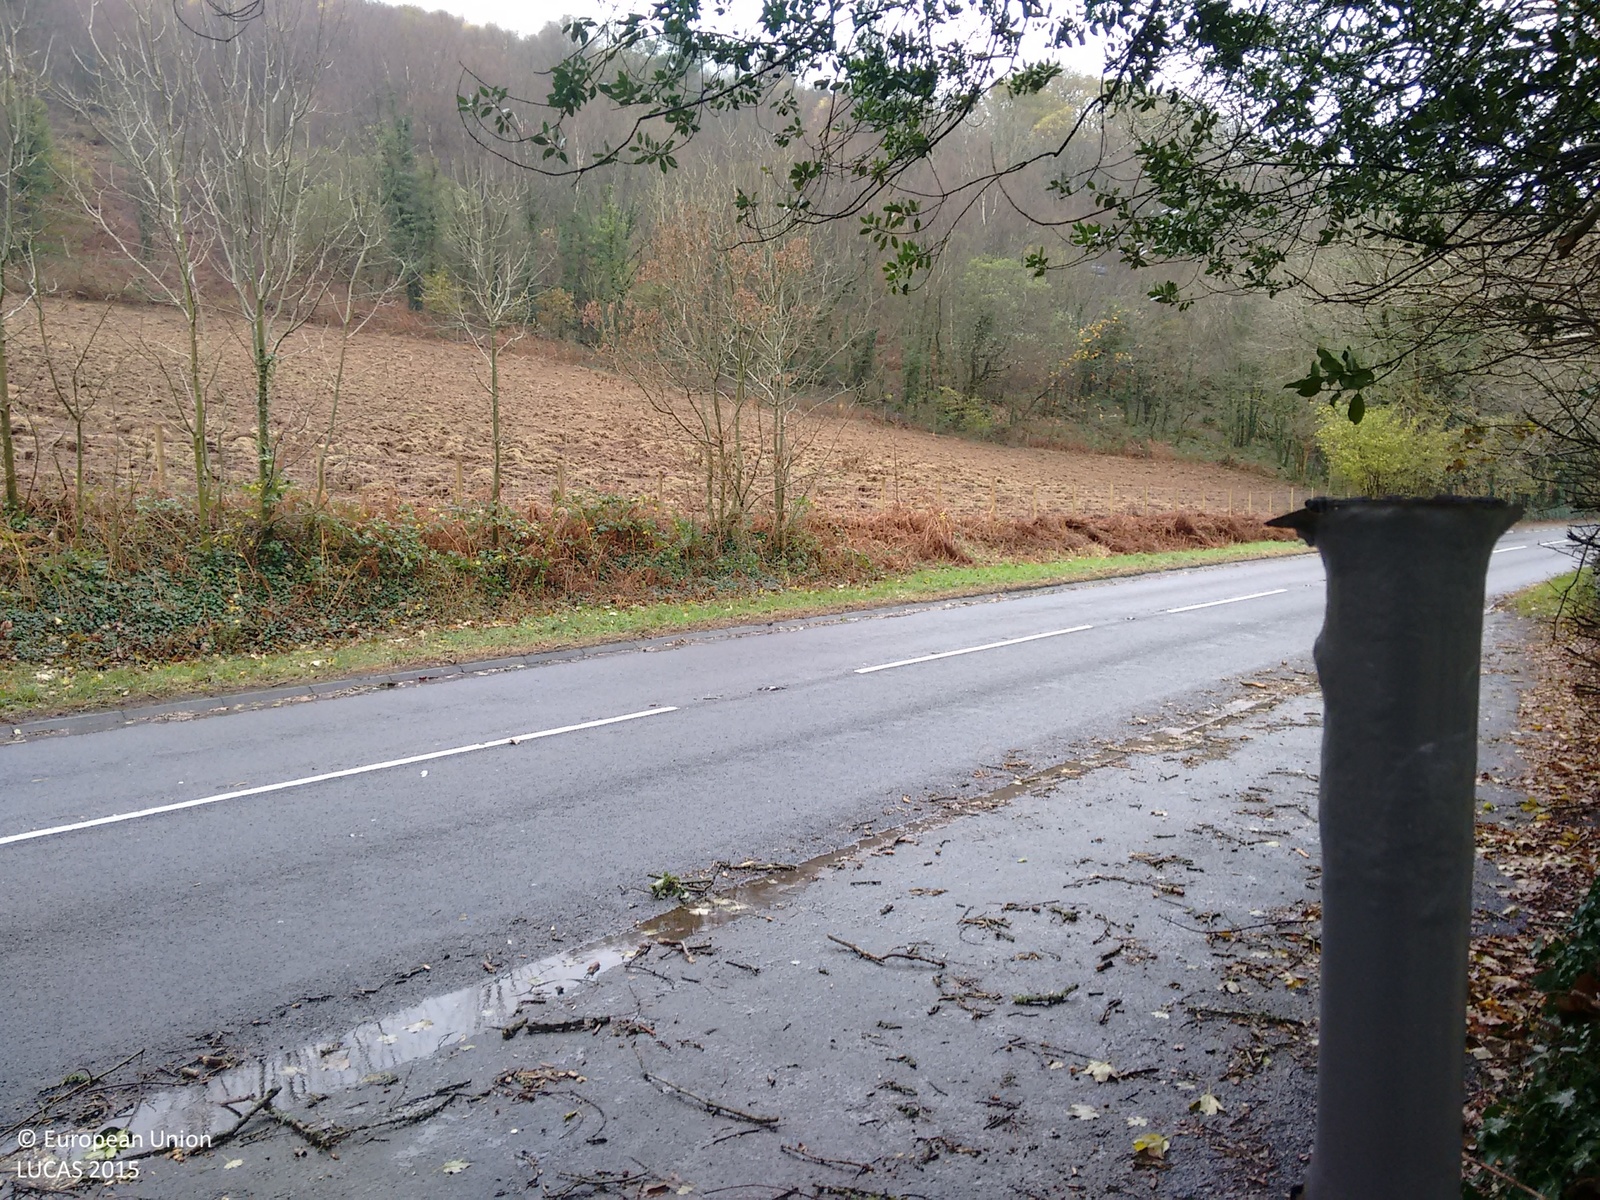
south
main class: Grassland
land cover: Grassland without tree/shrub cover
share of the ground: > 75 %
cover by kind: herbaceous plants 100 %
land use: Agriculture (excluding fallow land and kitchen gardens)
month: November
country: GB
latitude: 52.9507
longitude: -3.9803
